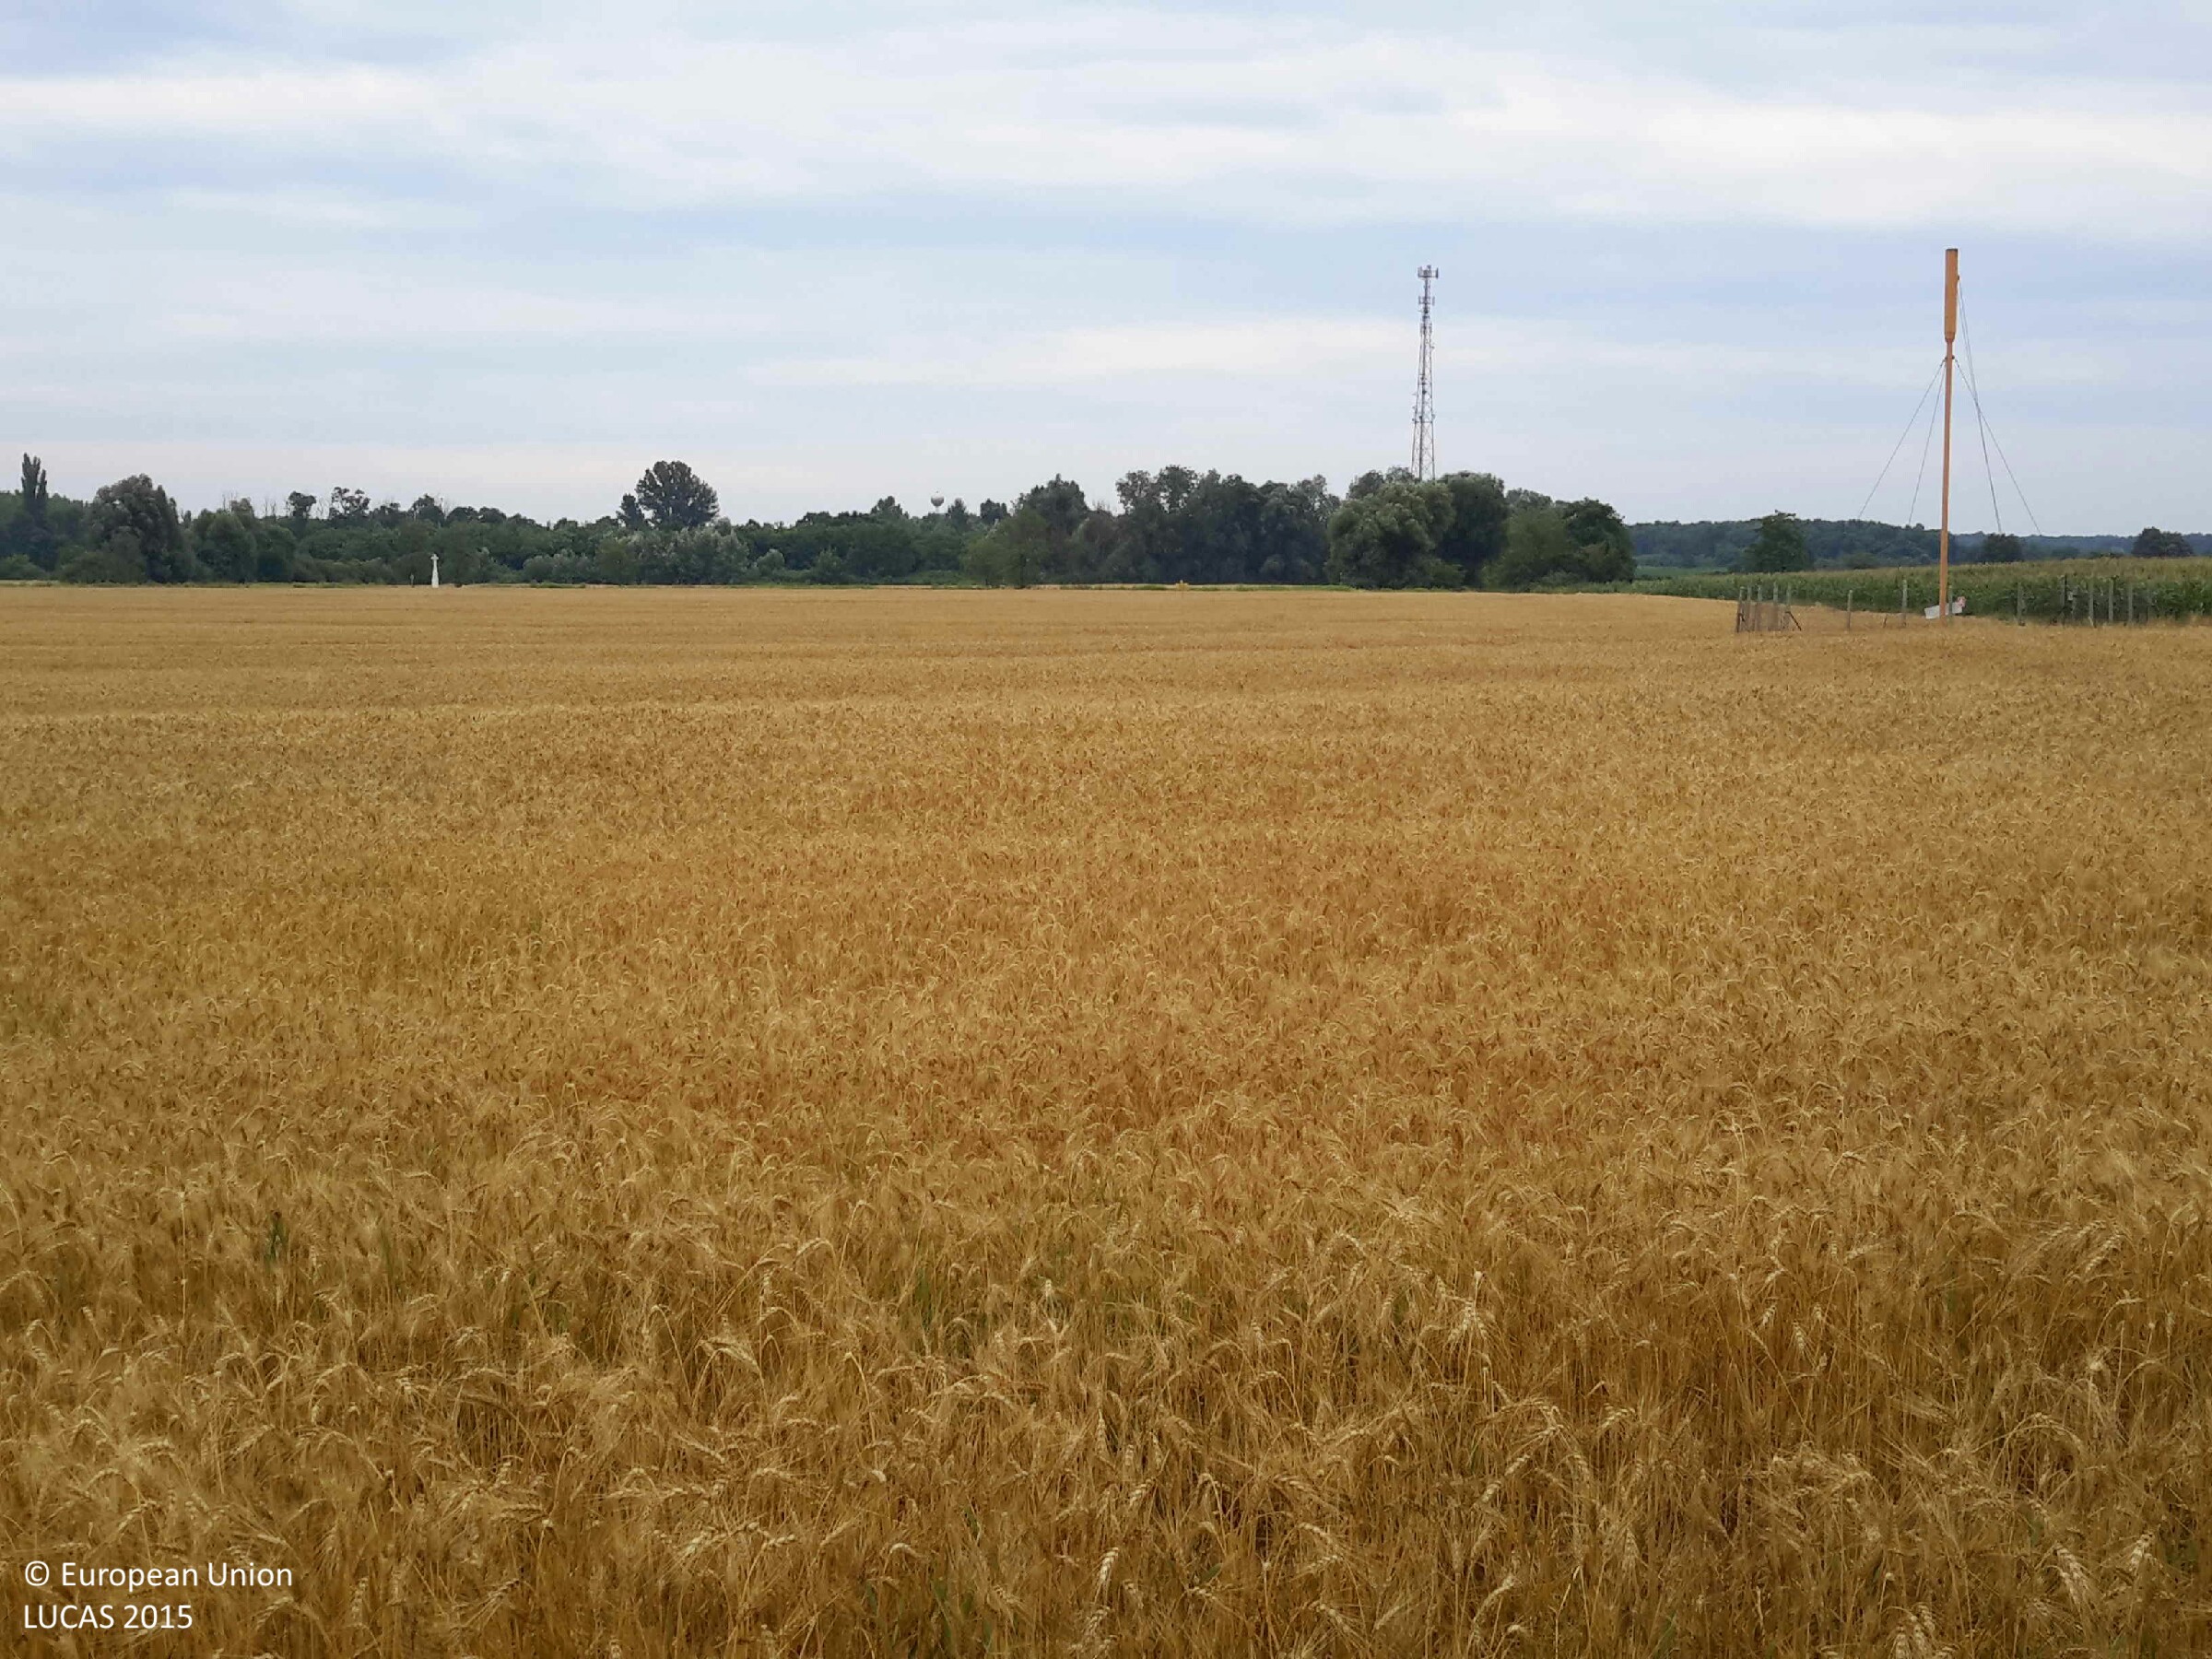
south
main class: Cropland
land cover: Common wheat
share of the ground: > 75 %
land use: Agriculture (excluding fallow land and kitchen gardens)
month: July
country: HU
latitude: 47.1214
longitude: 17.1891
